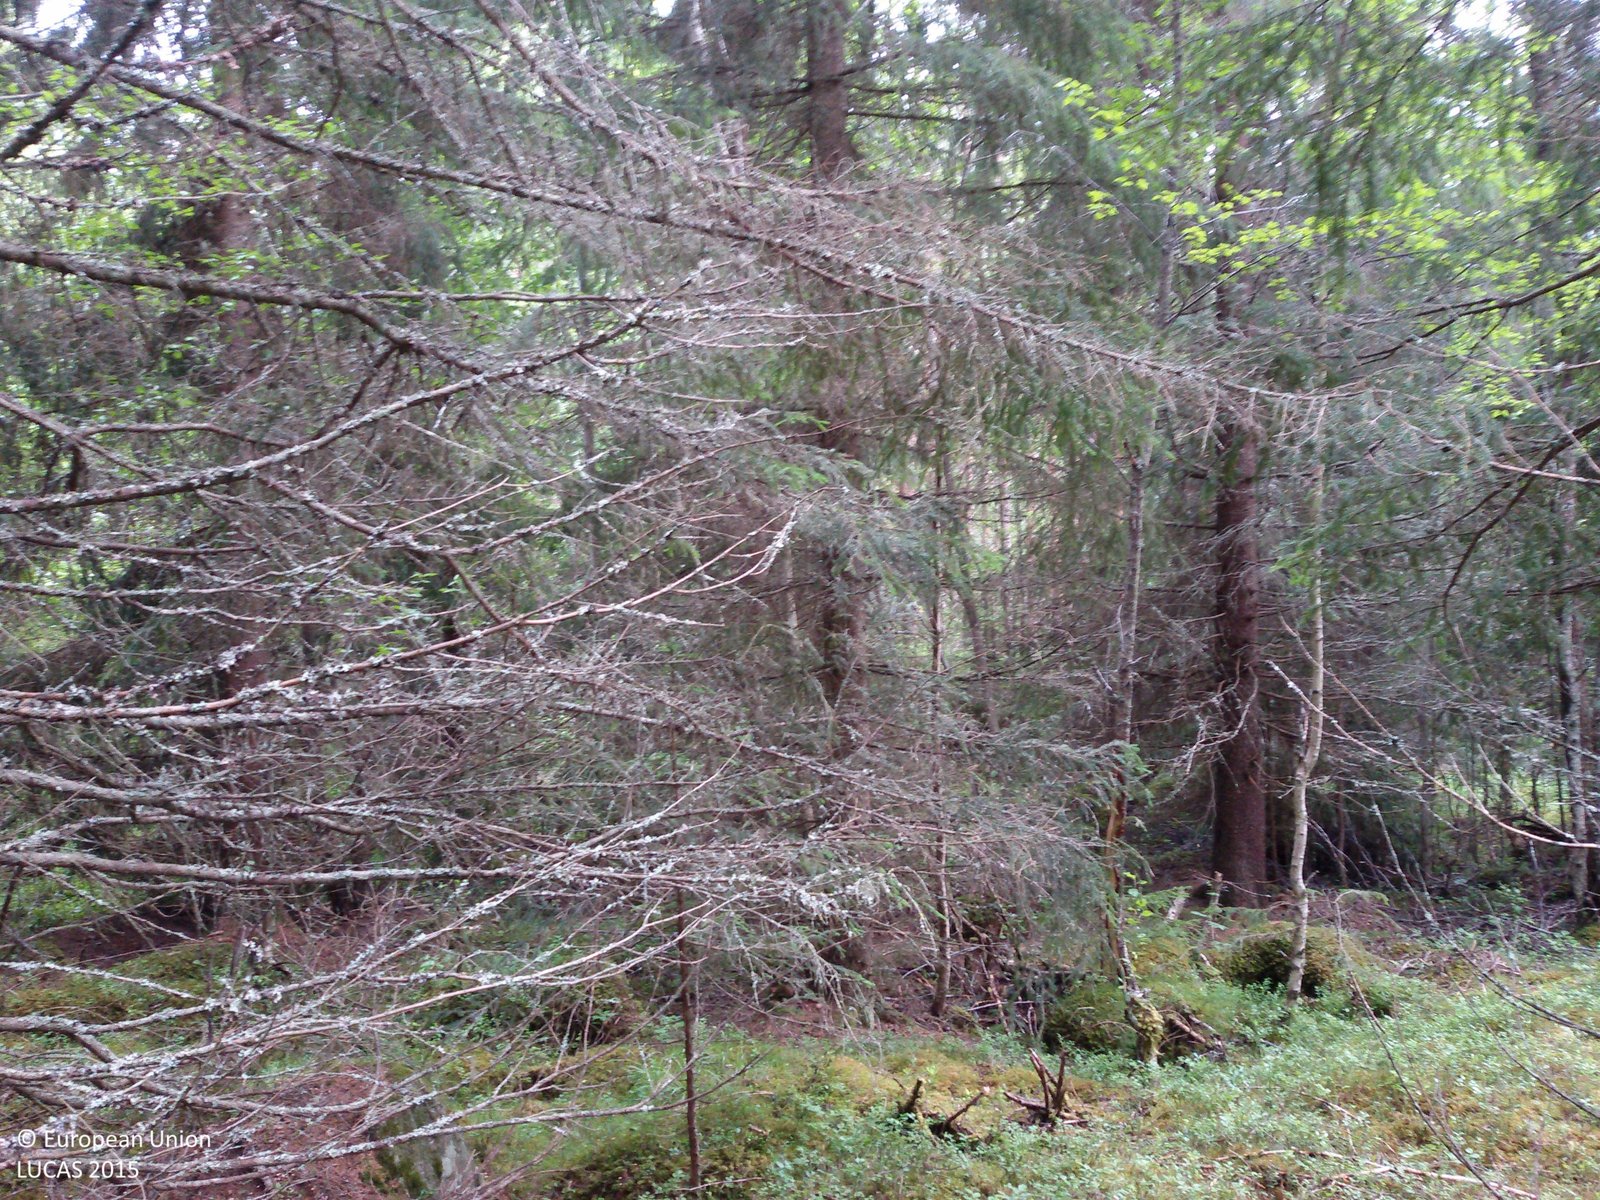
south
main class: Woodland
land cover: Spruce dominated coniferous woodland
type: boreal forest
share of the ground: > 75 %
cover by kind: coniferous forest trees 80 %, herbaceous plants 10 %, lichens and mosses 10 %
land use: Forestry
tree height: > 5 m
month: July
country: SE
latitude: 60.3649
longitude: 14.9378
